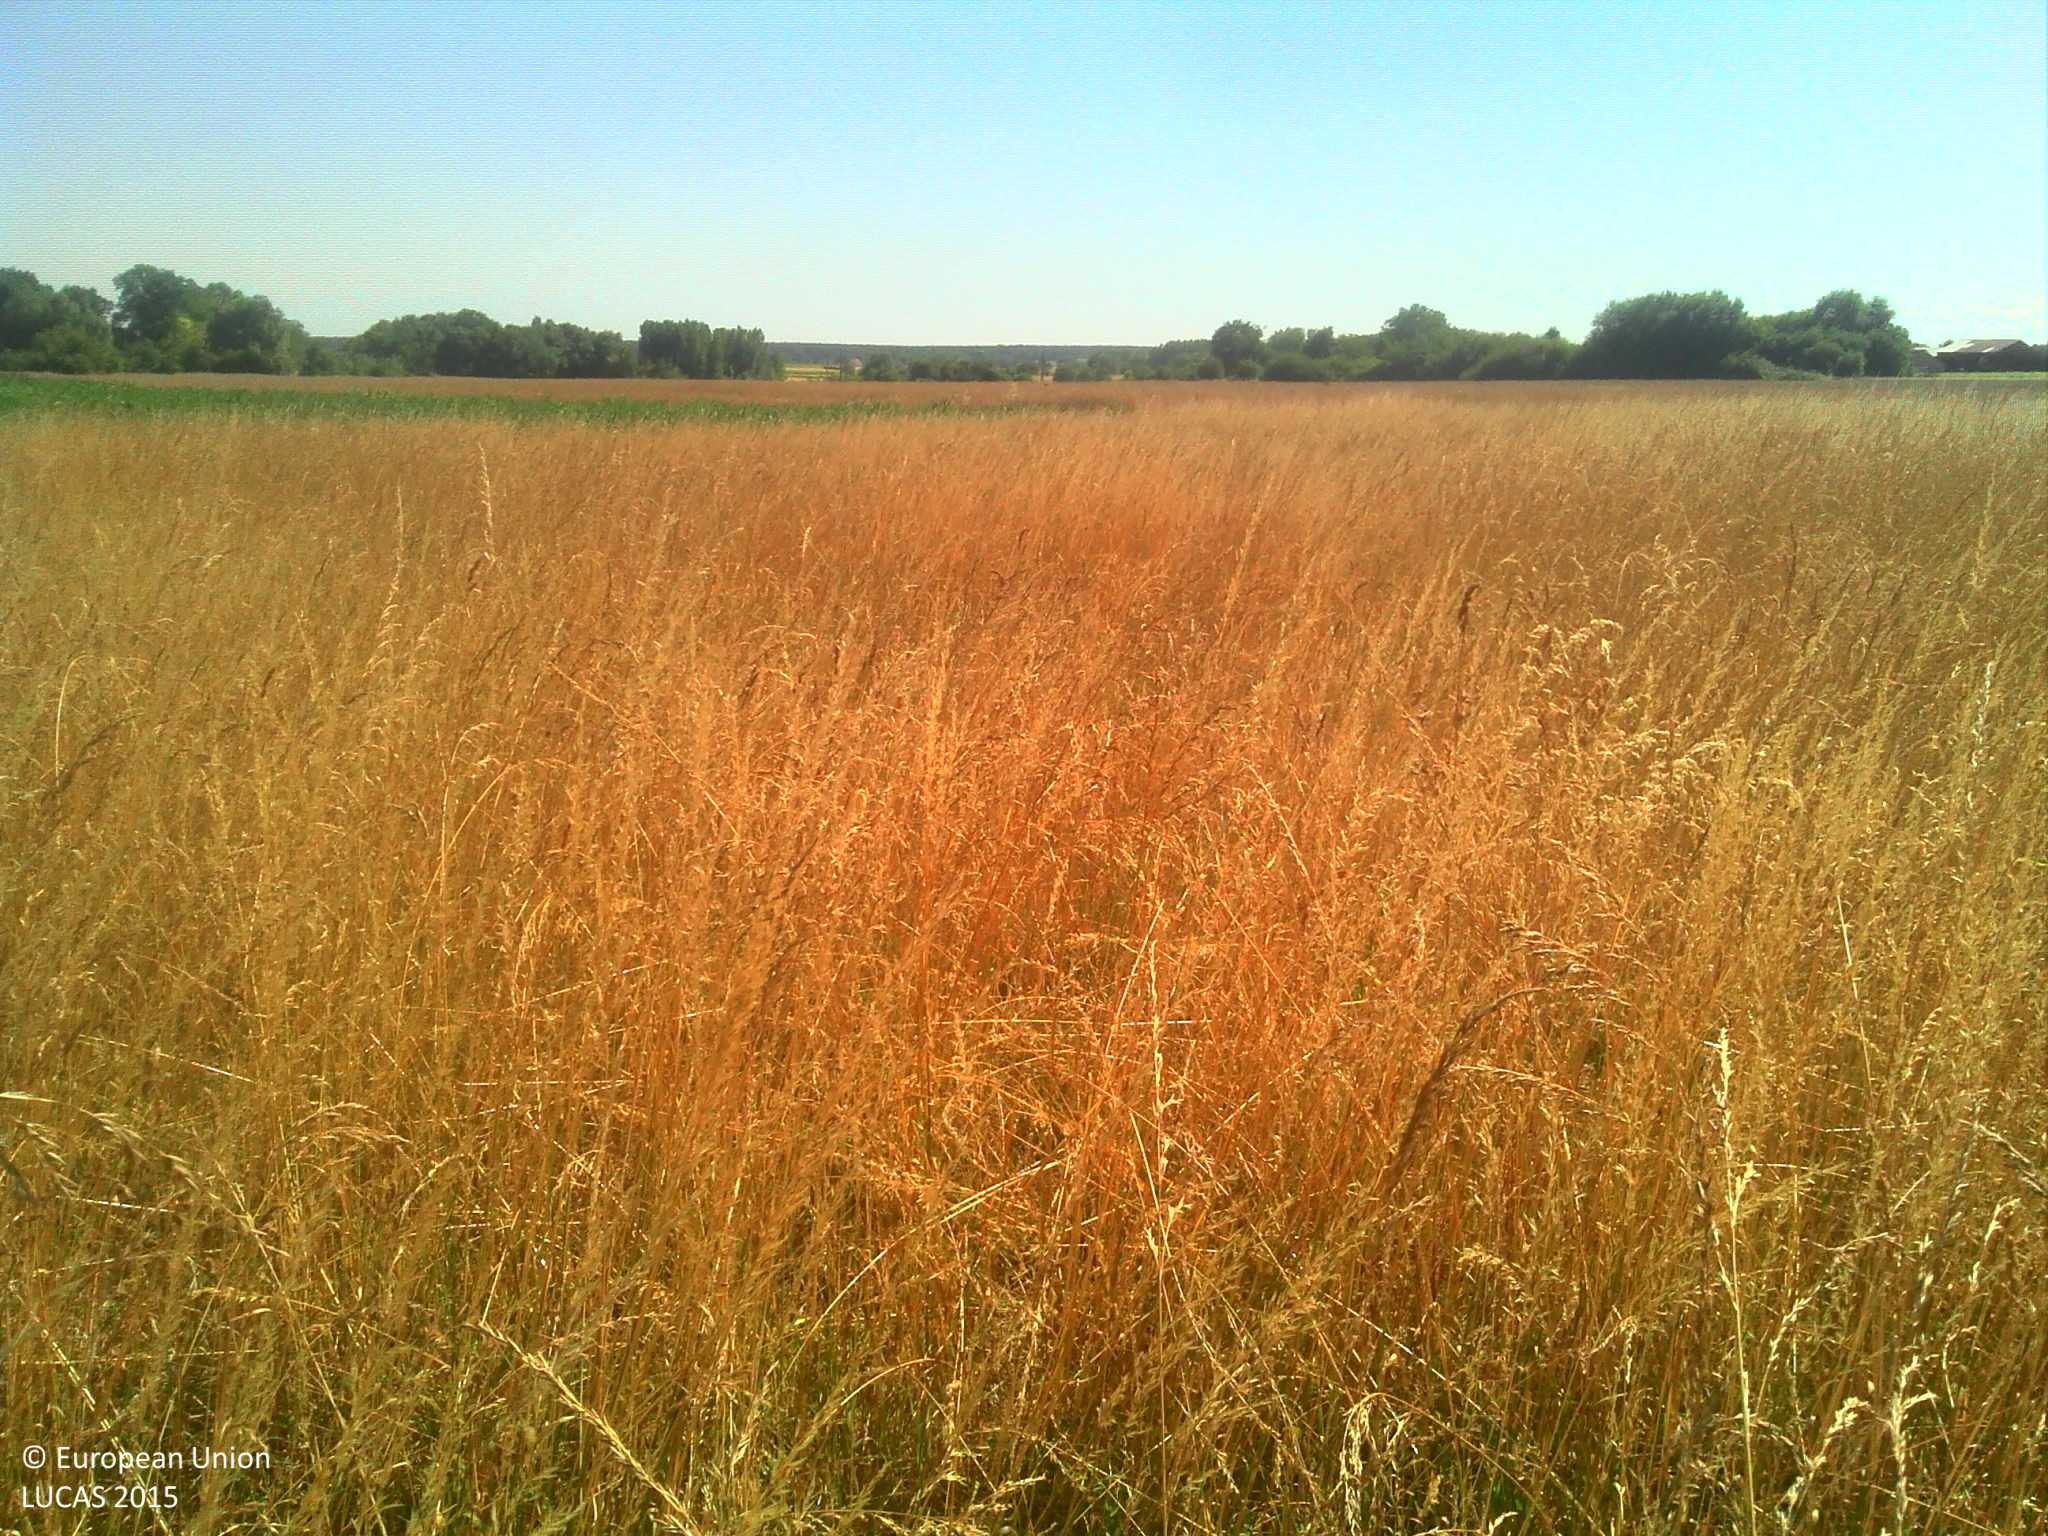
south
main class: Grassland
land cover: Grassland without tree/shrub cover
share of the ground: > 75 %
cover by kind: herbaceous plants 100 %
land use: Agriculture (excluding fallow land and kitchen gardens)
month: June
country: FR
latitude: 47.3458
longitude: 1.4221
